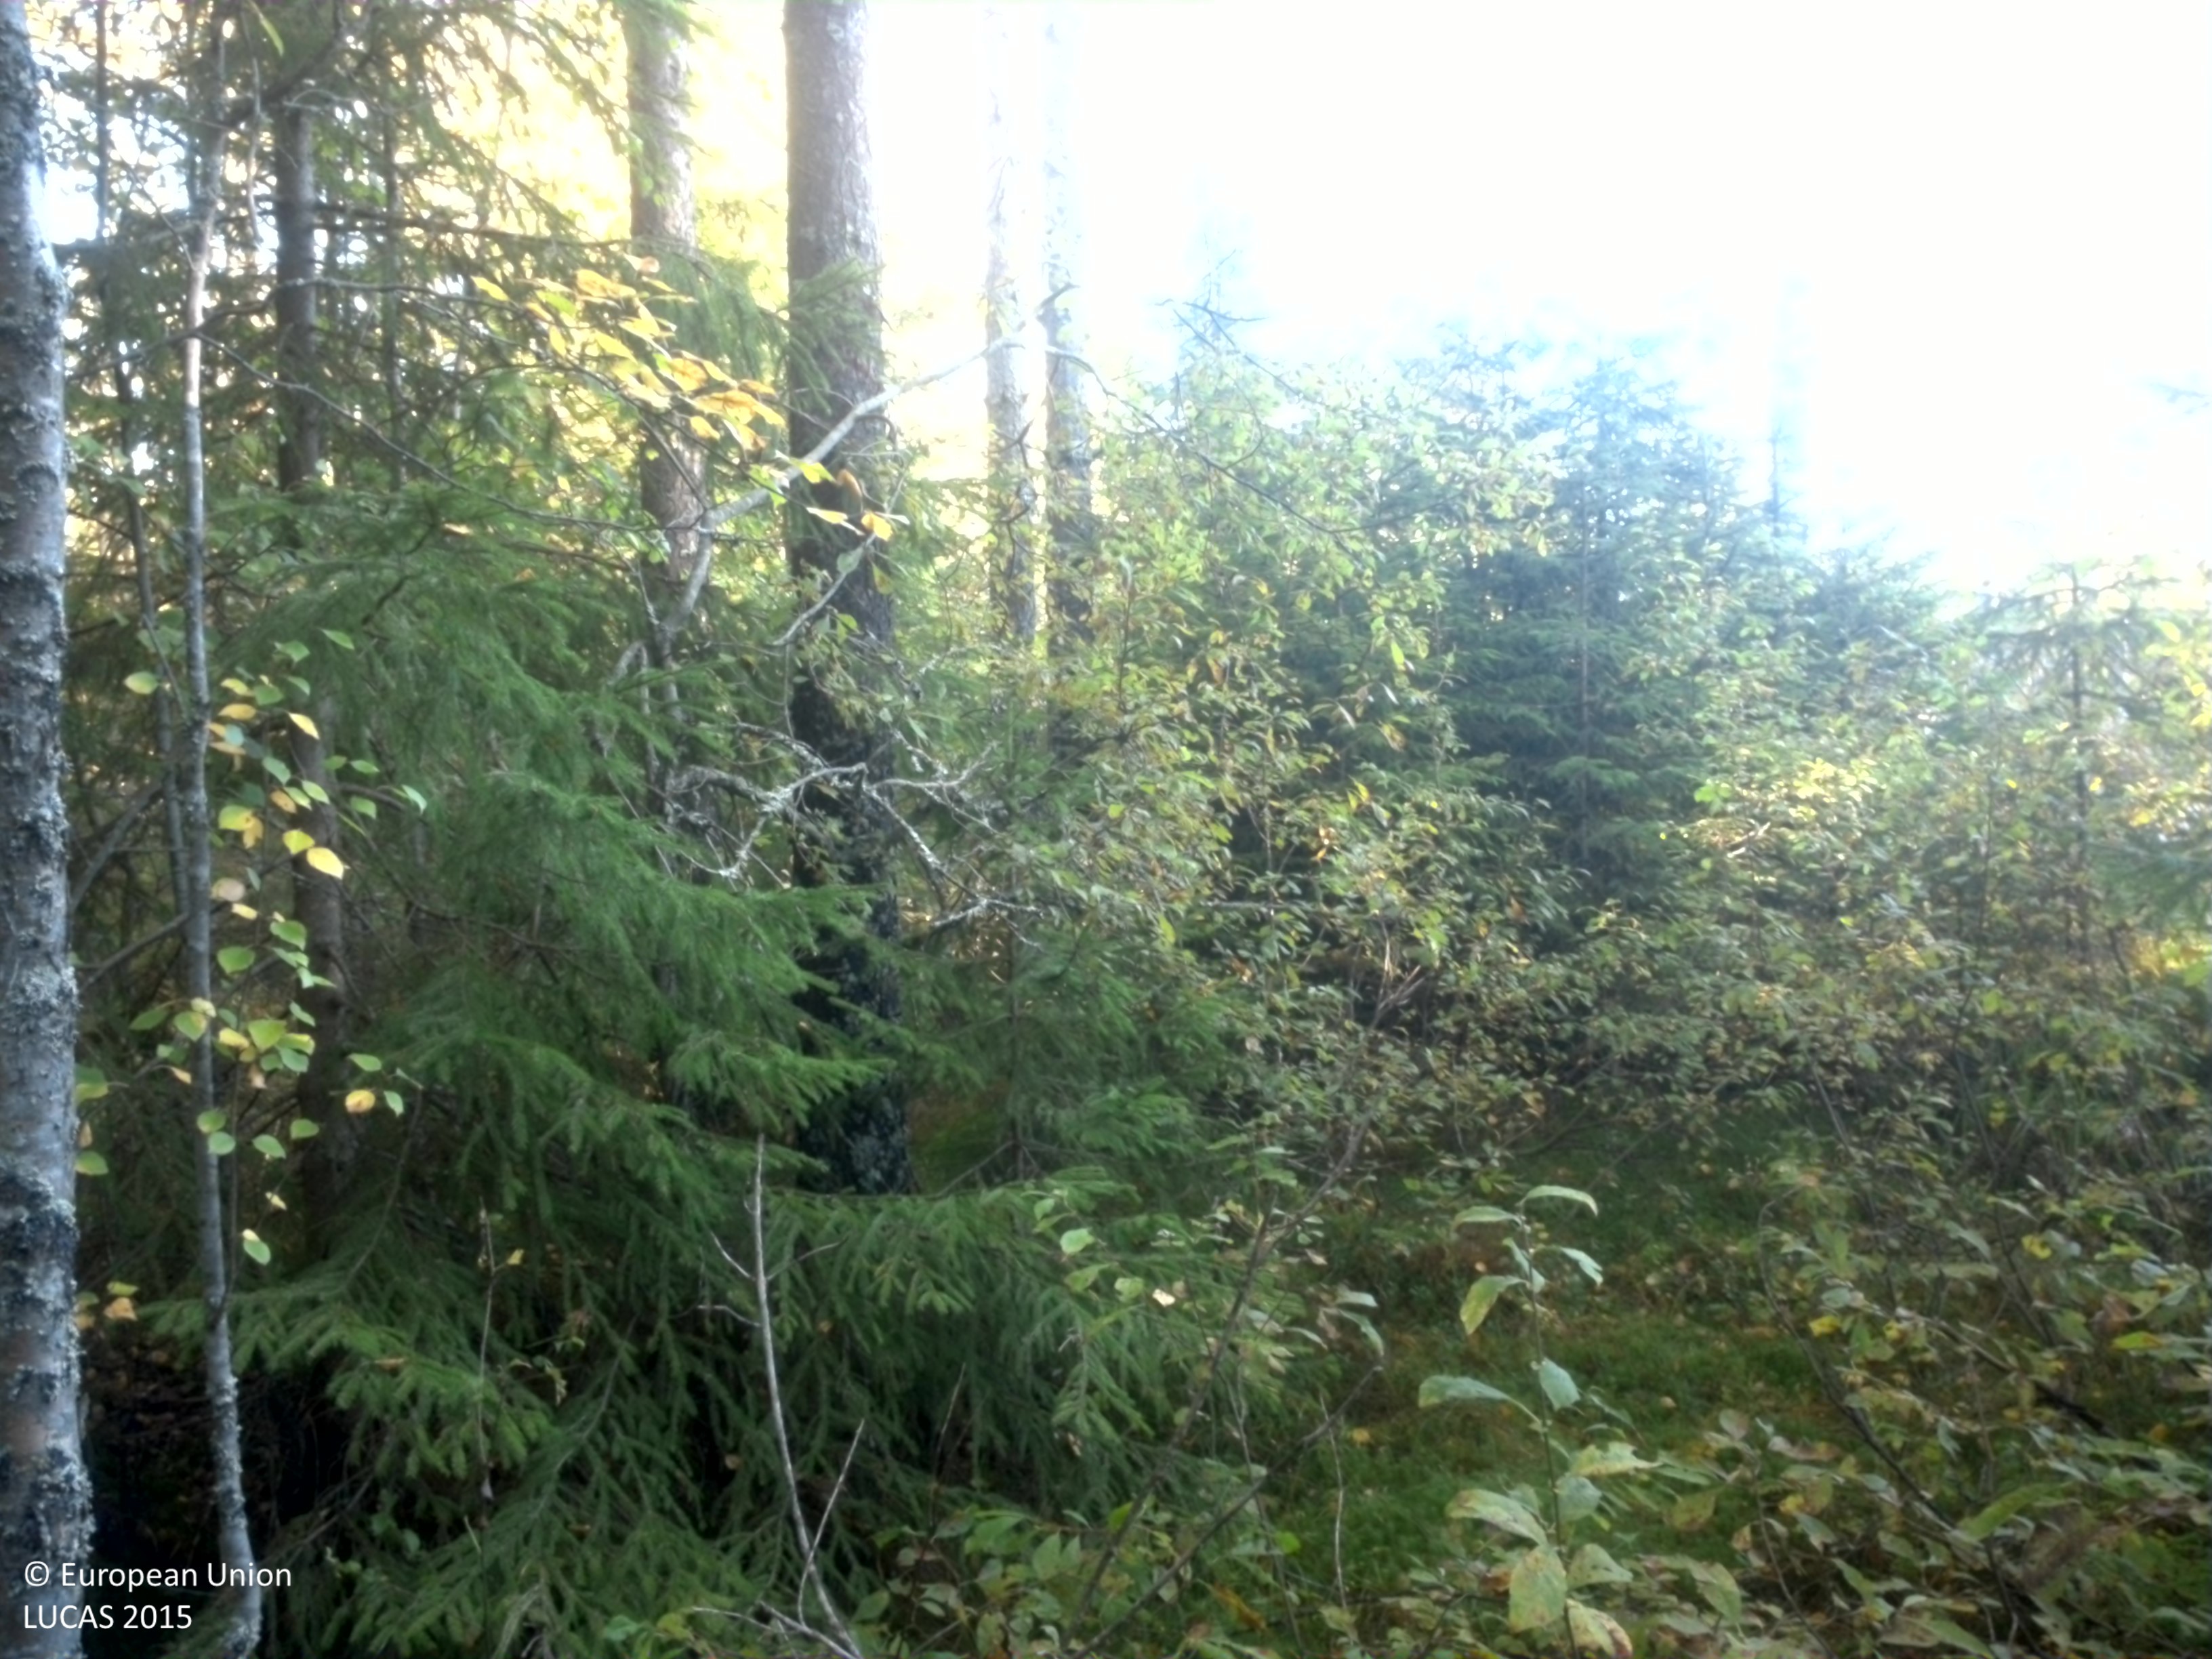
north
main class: Woodland
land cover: Pine dominated mixed woodland
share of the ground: > 75 %
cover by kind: coniferous forest trees 50 %, broadleaved forest trees 25 %, shrubs 10 %, lichens and mosses 10 %, herbaceous plants 5 %
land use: Forestry
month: September
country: SE
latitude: 59.9007
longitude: 15.2991
